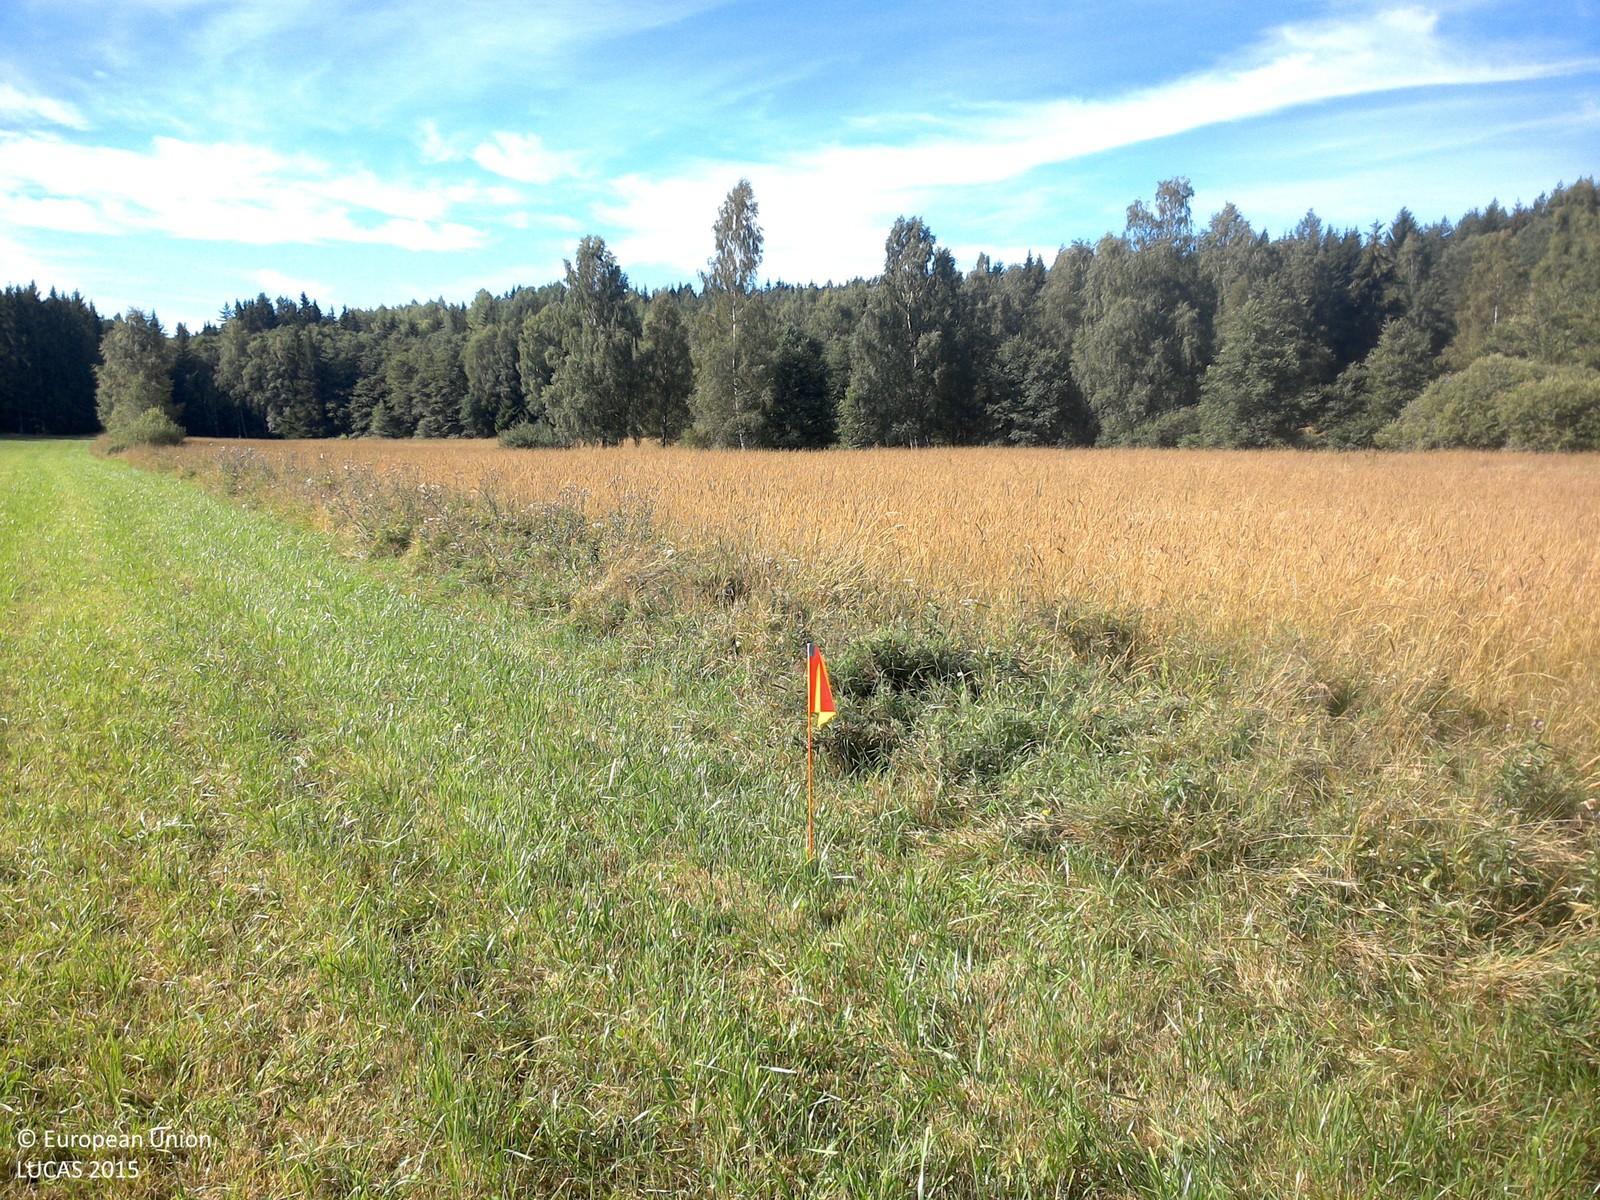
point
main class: Cropland
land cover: Other leguminous and mixtures for fodder
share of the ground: > 75 %
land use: Agriculture (excluding fallow land and kitchen gardens)
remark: Harvested field
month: August
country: SE
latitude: 58.2545
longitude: 14.9530
